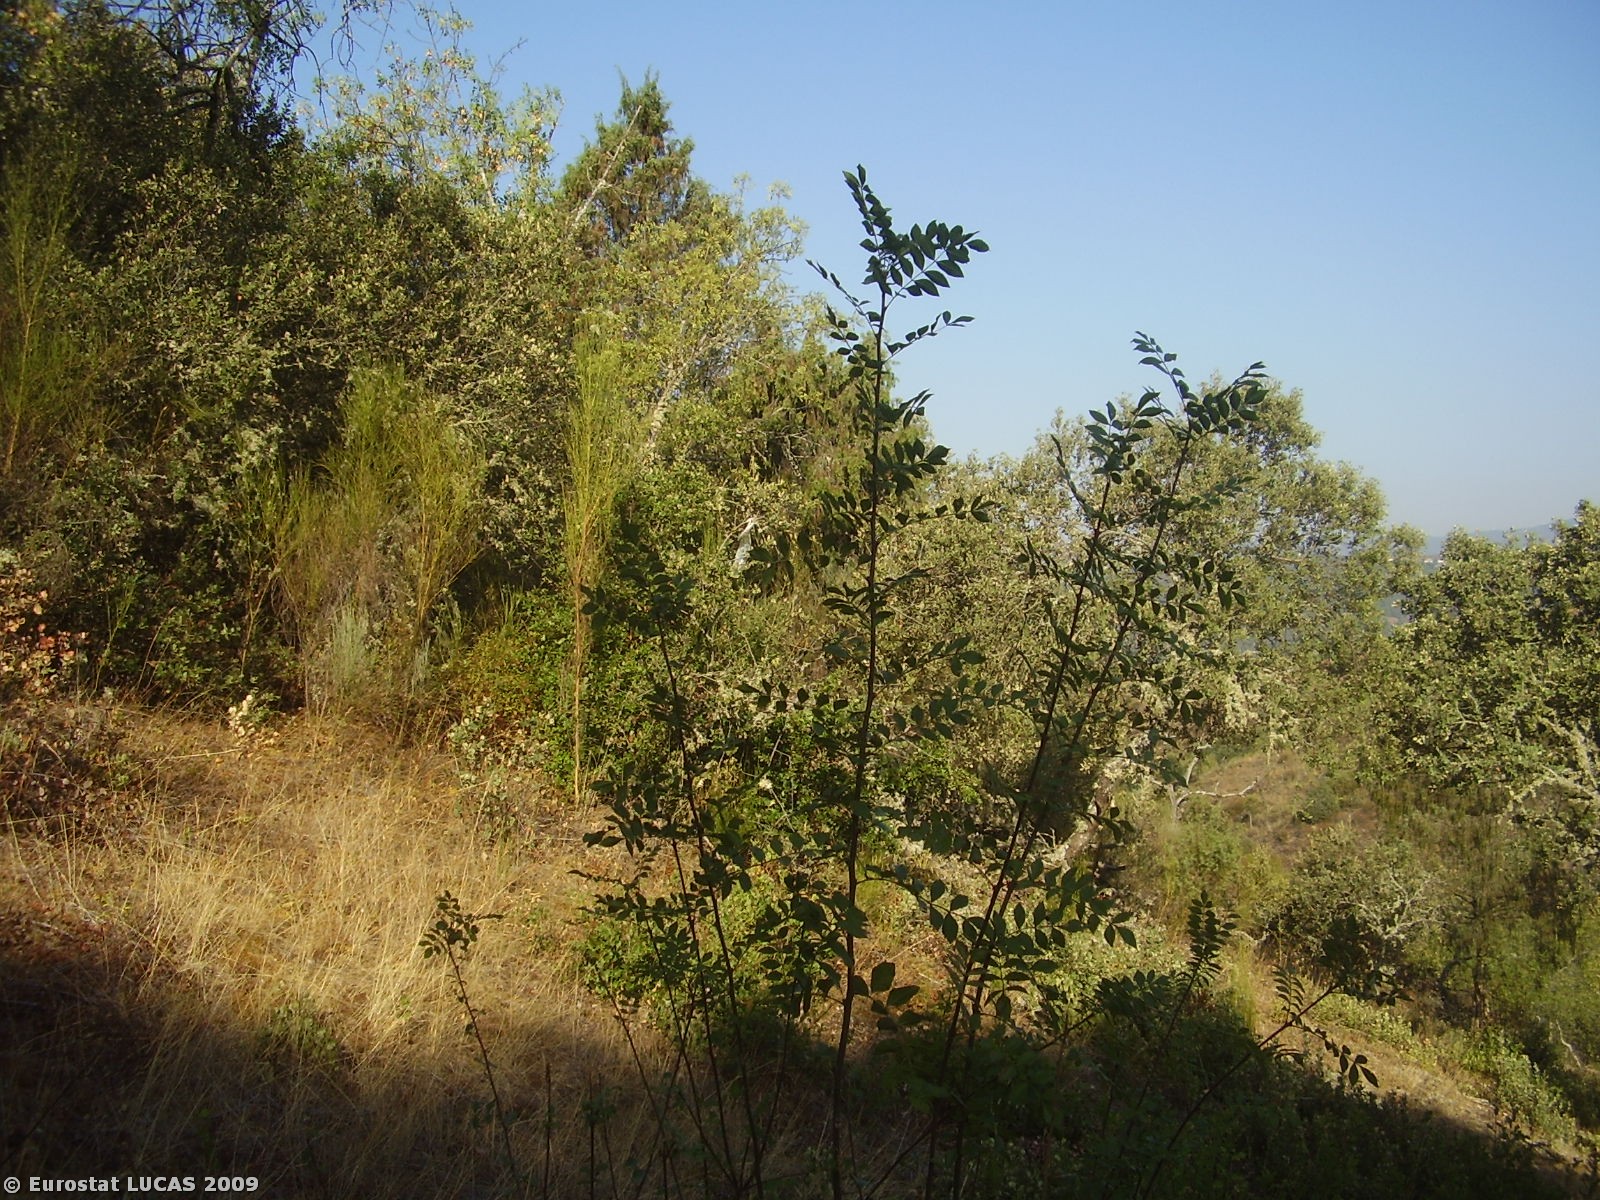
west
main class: Woodland
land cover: Broadleaved woodland
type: broadleaved evergreen forest
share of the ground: 10 - 25 %
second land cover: Spontaneously vegetated surfaces
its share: > 75 %
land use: Forestry
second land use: Fallow land
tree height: > 5 m
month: August
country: PT
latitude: 41.3879
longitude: -6.7904
